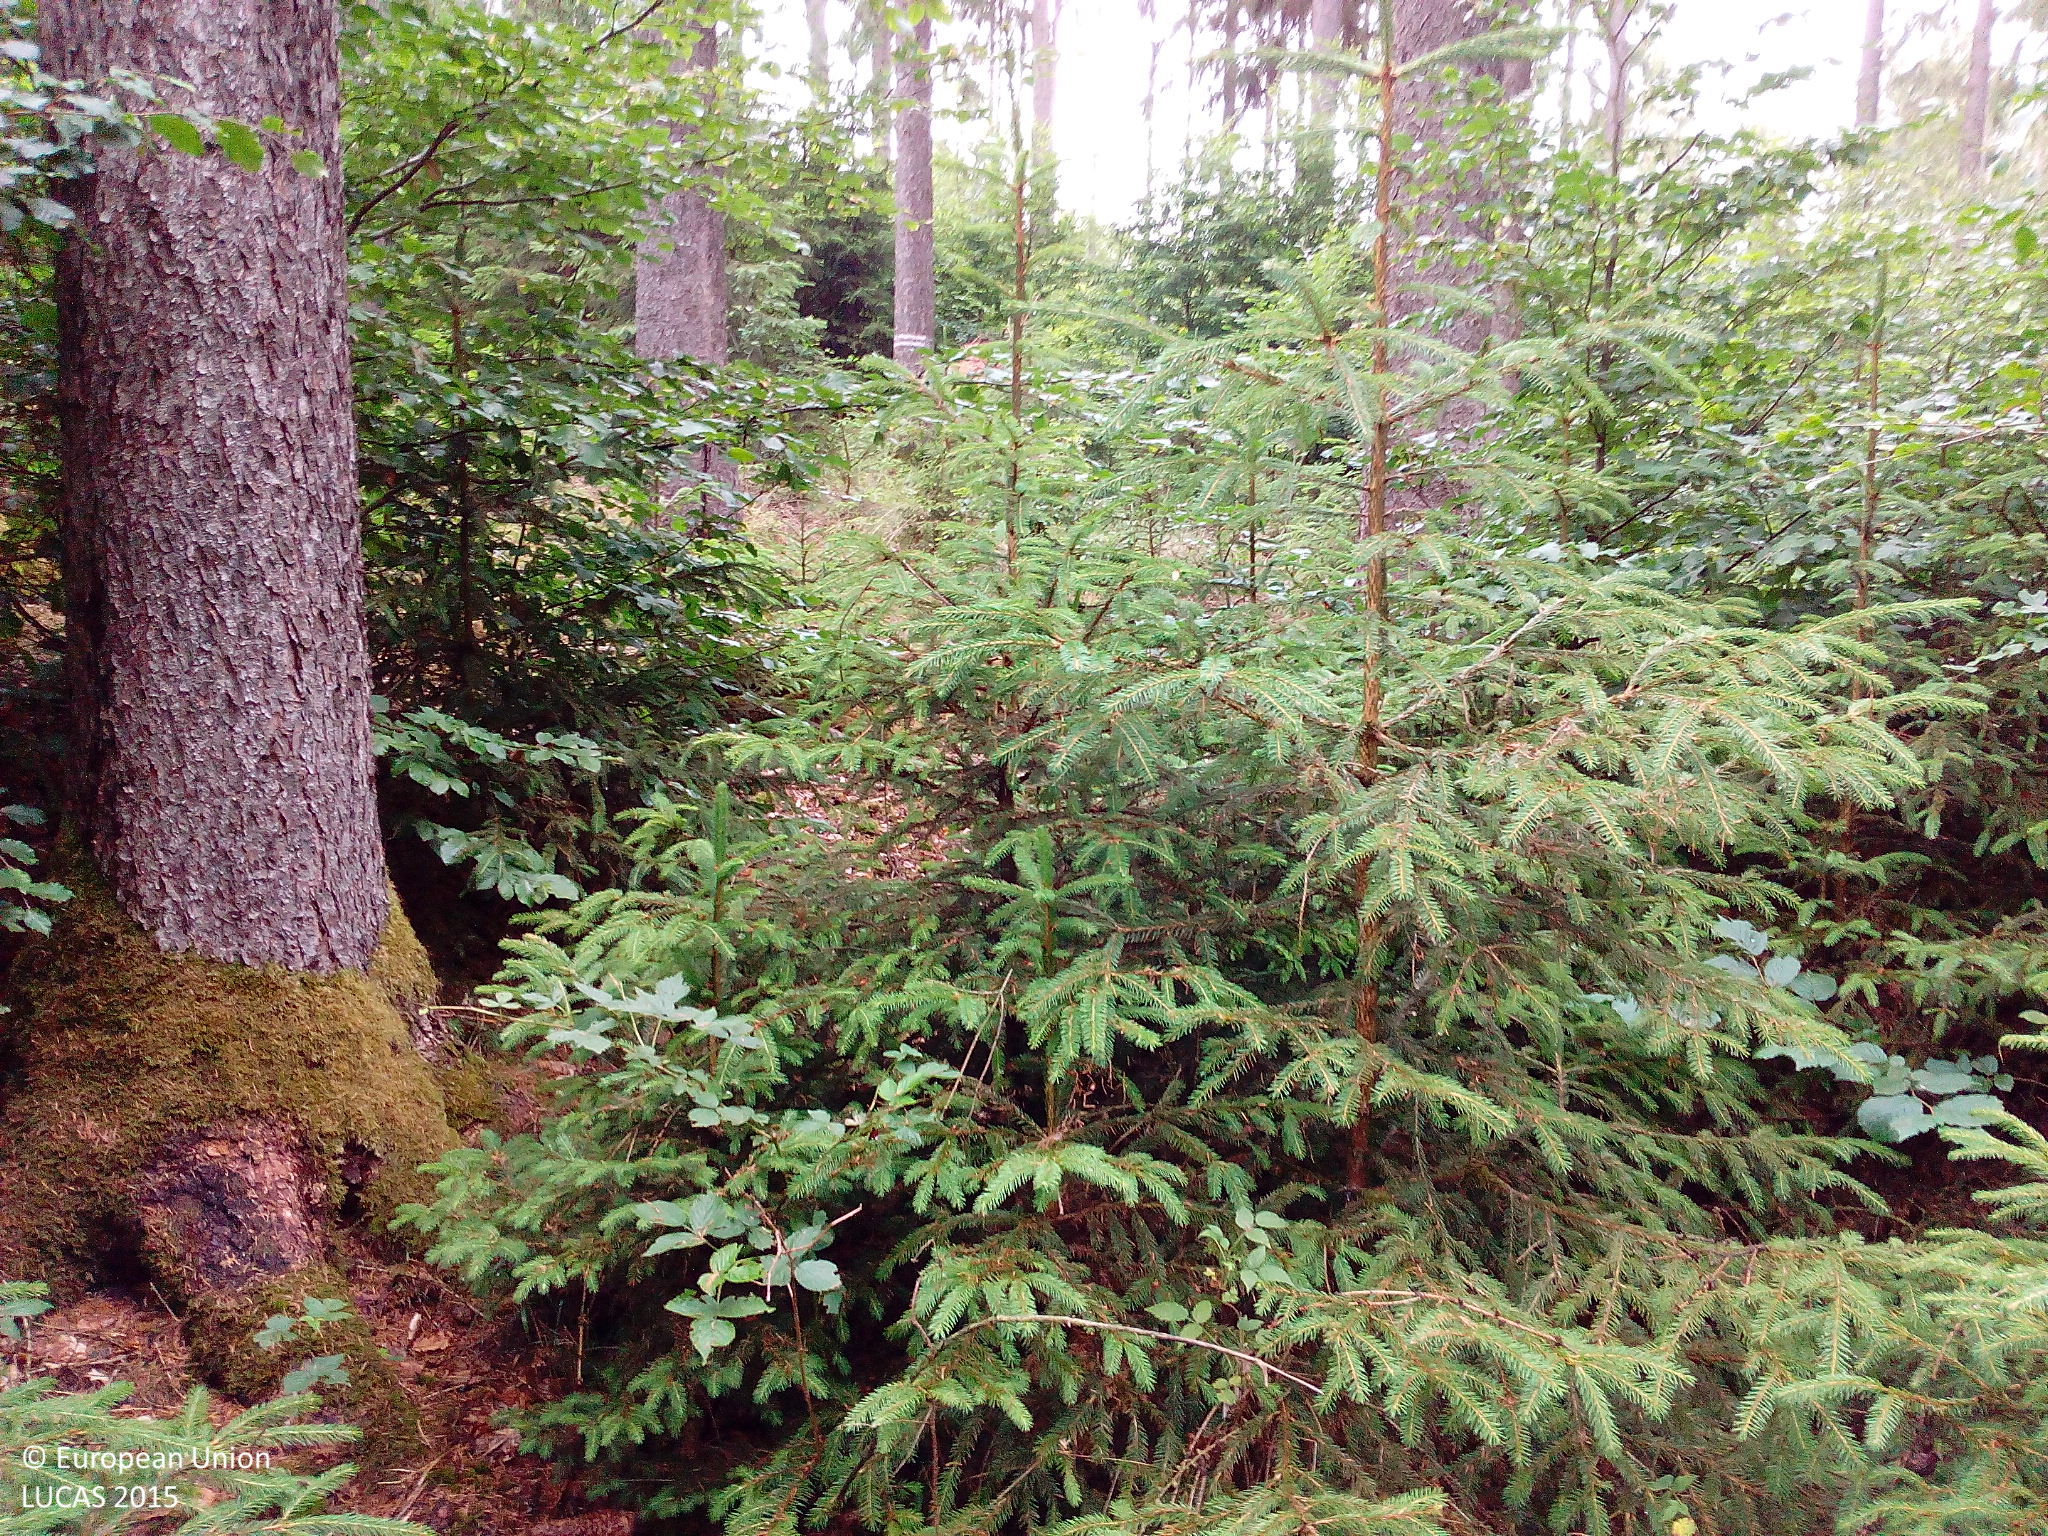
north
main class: Woodland
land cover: Spruce dominated mixed woodland
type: hemiboreal forest and nemoral coniferous forest and mixed broadleaved-coniferous forest
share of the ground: > 75 %
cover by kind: coniferous forest trees 40 %, broadleaved forest trees 30 %, unconsolidated bare surface 20 %, herbaceous plants 5 %, lichens and mosses 5 %
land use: Forestry
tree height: > 5 m
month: July
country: DE
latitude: 51.0292
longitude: 9.8717
